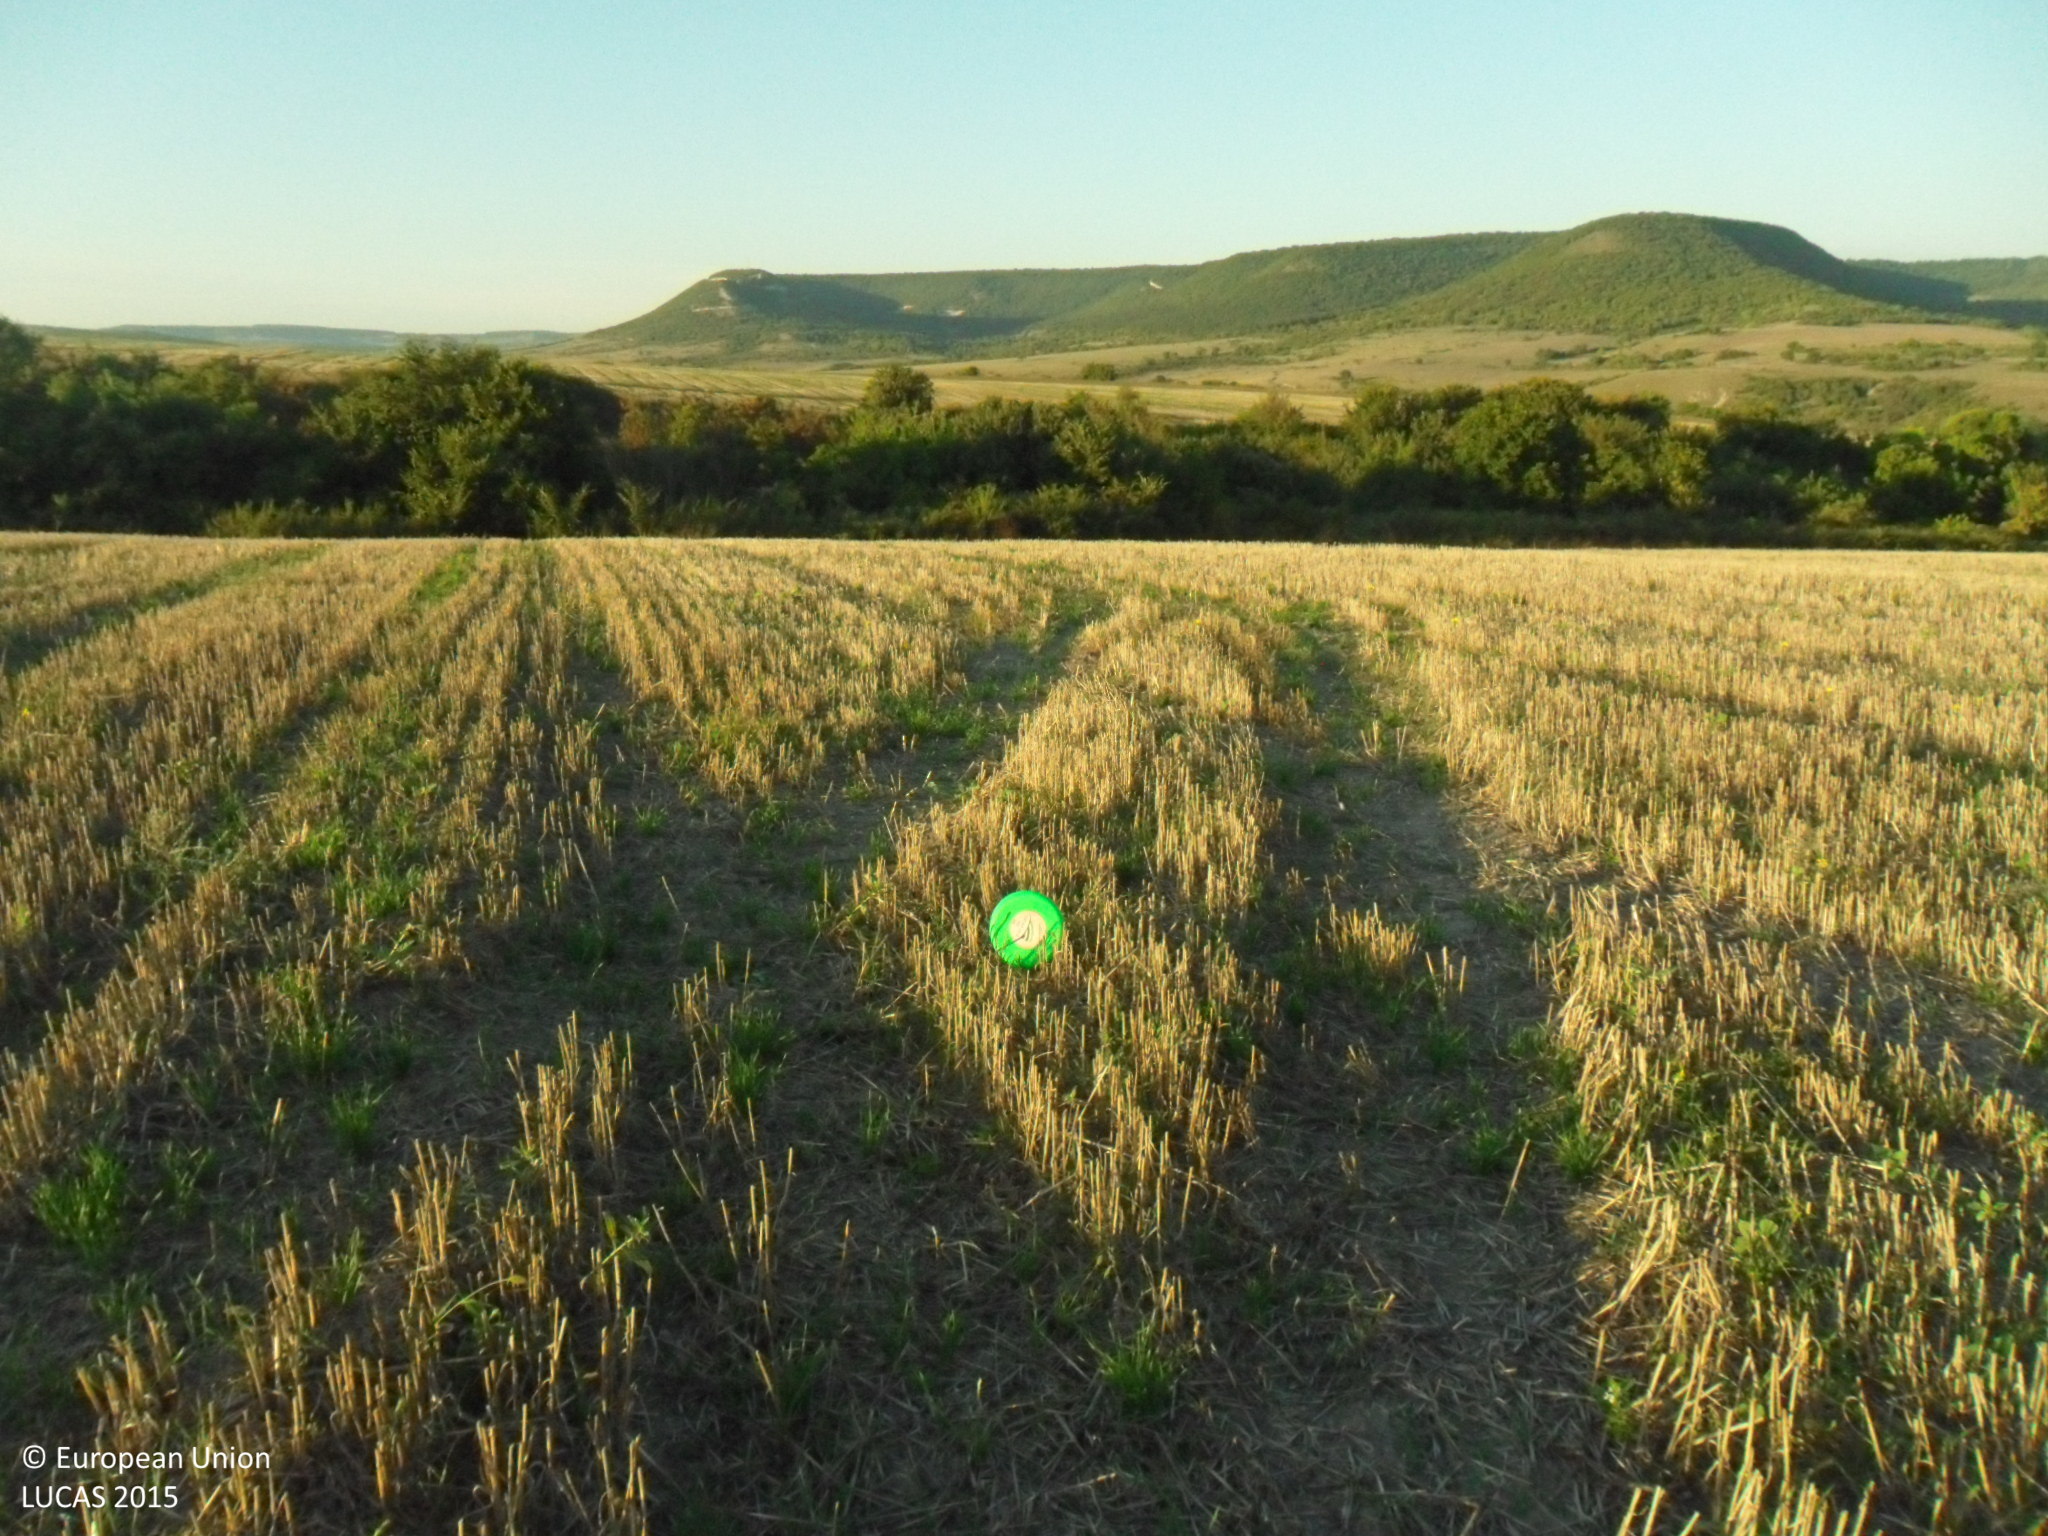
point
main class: Cropland
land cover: Common wheat
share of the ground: > 75 %
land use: Agriculture (excluding fallow land and kitchen gardens)
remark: Harvested field
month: September
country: BG
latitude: 43.4245
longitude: 27.1541
